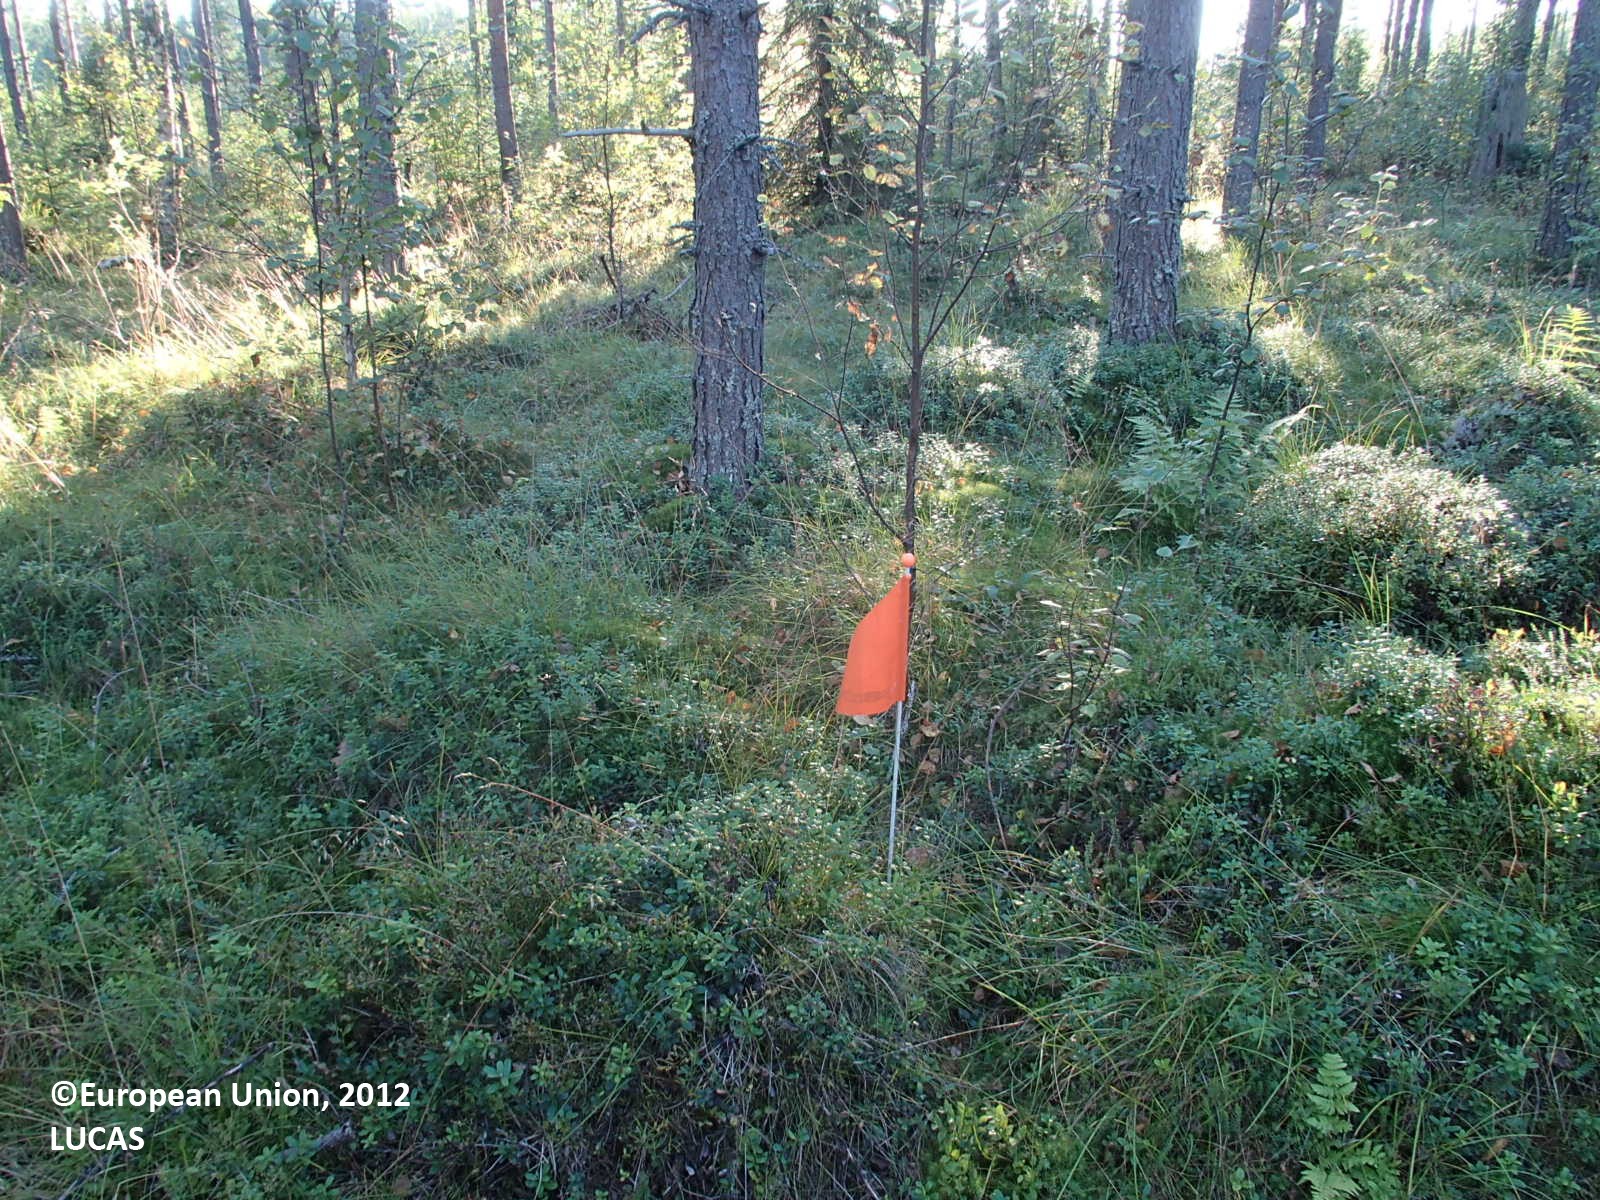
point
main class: Woodland
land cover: Pine dominated mixed woodland
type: boreal forest
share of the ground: 50 - 75 %
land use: Forestry
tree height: > 5 m
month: August
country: FI
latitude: 63.4999
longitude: 28.0311
